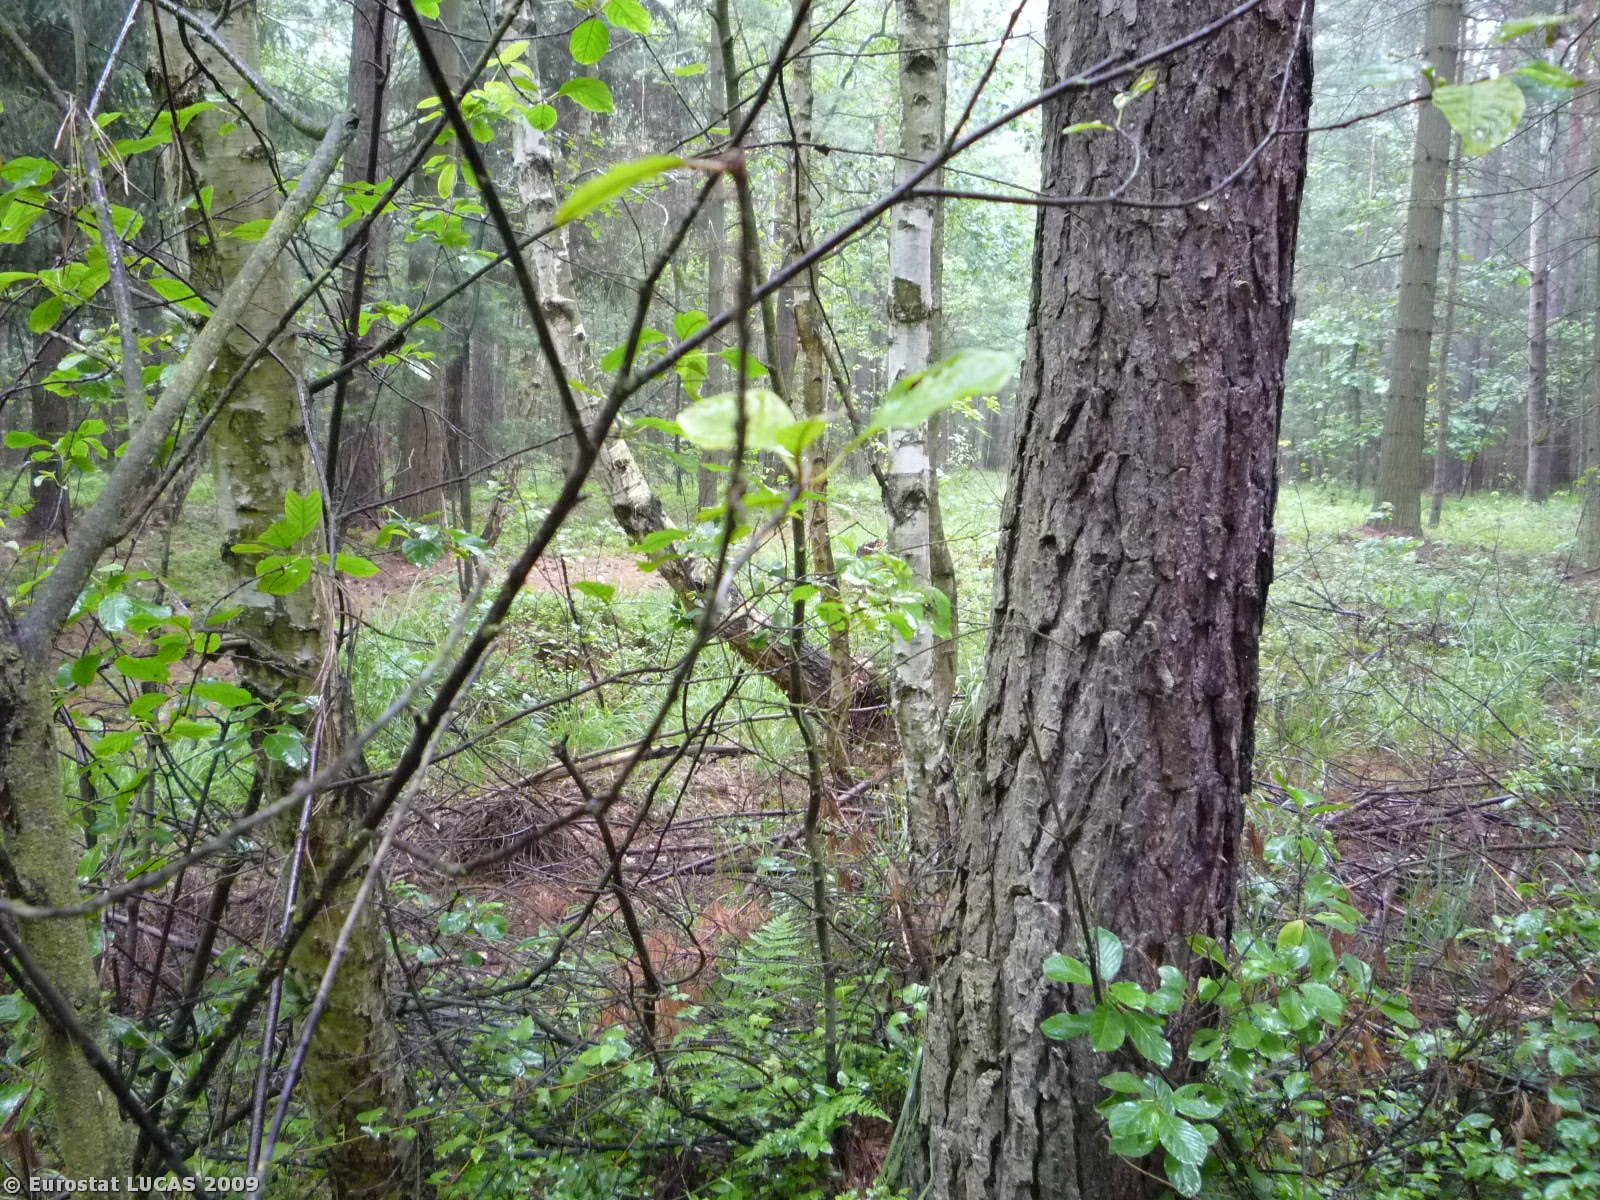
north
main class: Woodland
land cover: Mixed woodland
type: hemiboreal forest and nemoral coniferous forest and mixed broadleaved-coniferous forest
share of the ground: > 75 %
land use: Forestry
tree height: > 5 m
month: June
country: CZ
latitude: 50.0725
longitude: 15.4390
